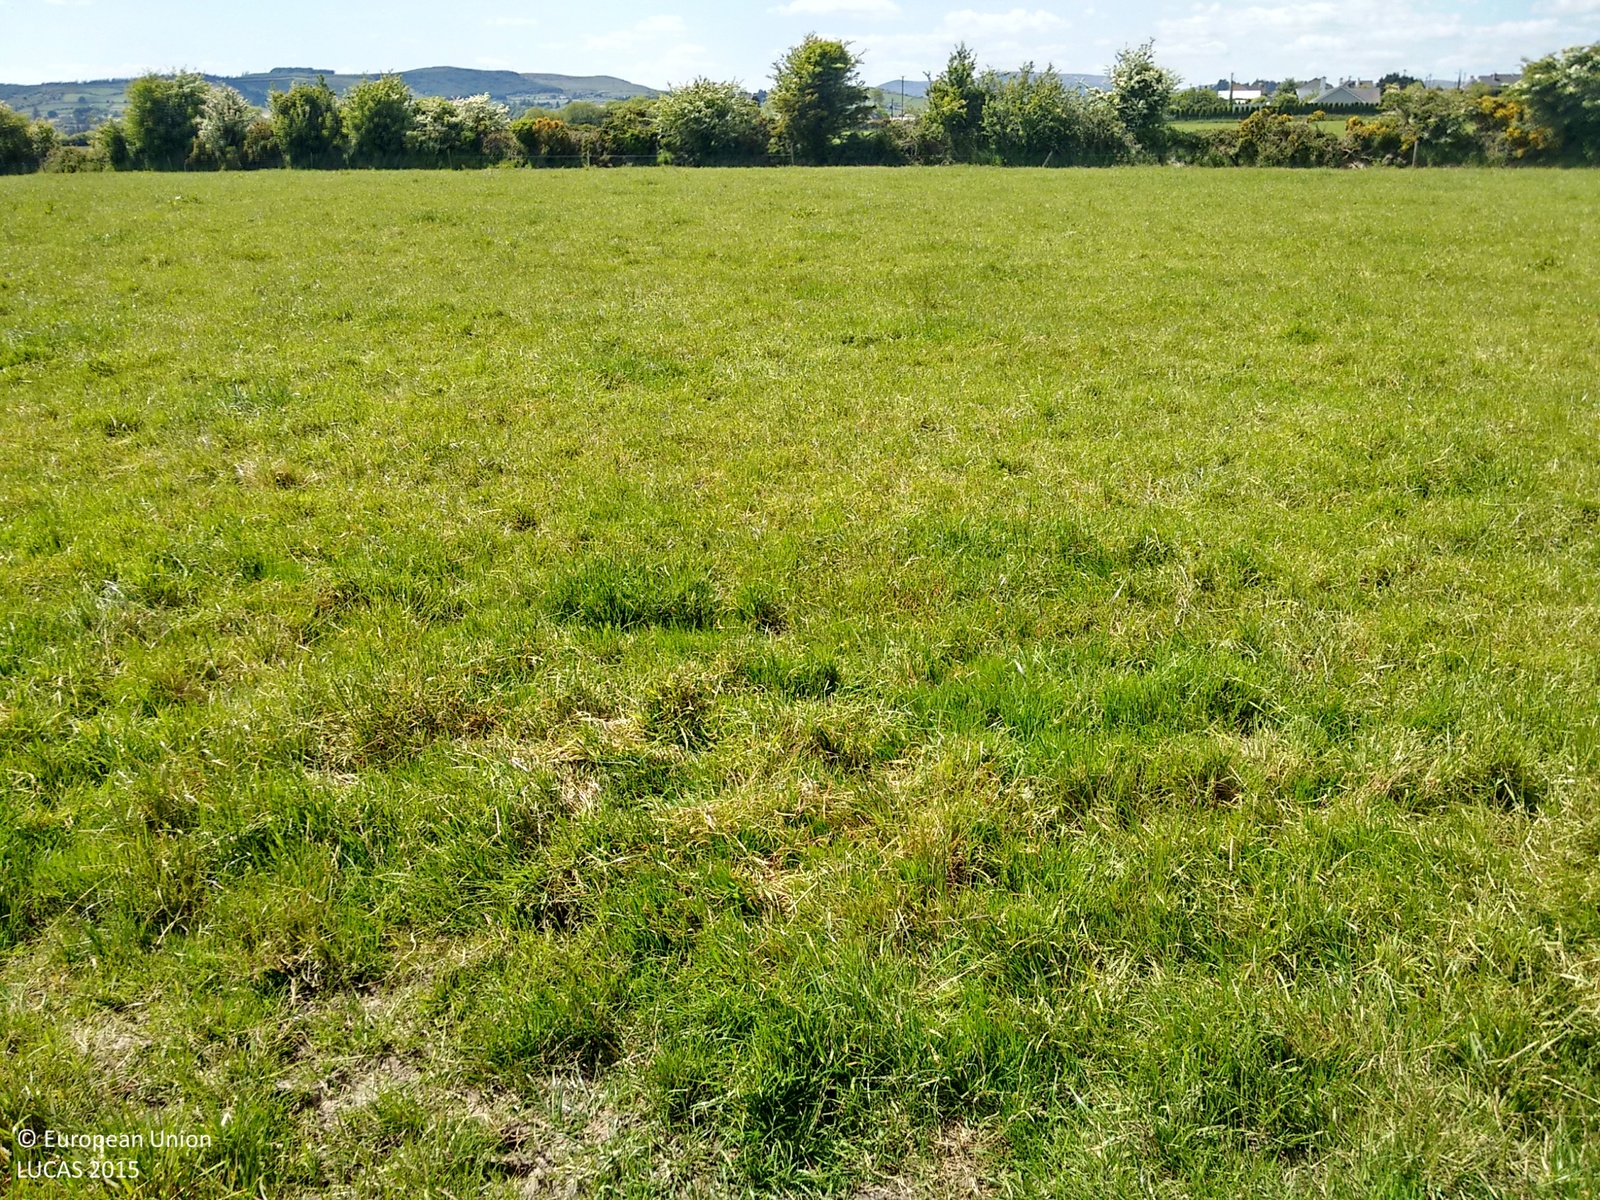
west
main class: Grassland
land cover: Grassland without tree/shrub cover
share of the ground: > 75 %
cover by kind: herbaceous plants 95 %, shrubs 5 %
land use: Agriculture (excluding fallow land and kitchen gardens)
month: June
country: IE
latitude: 51.9785
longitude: -8.8270
